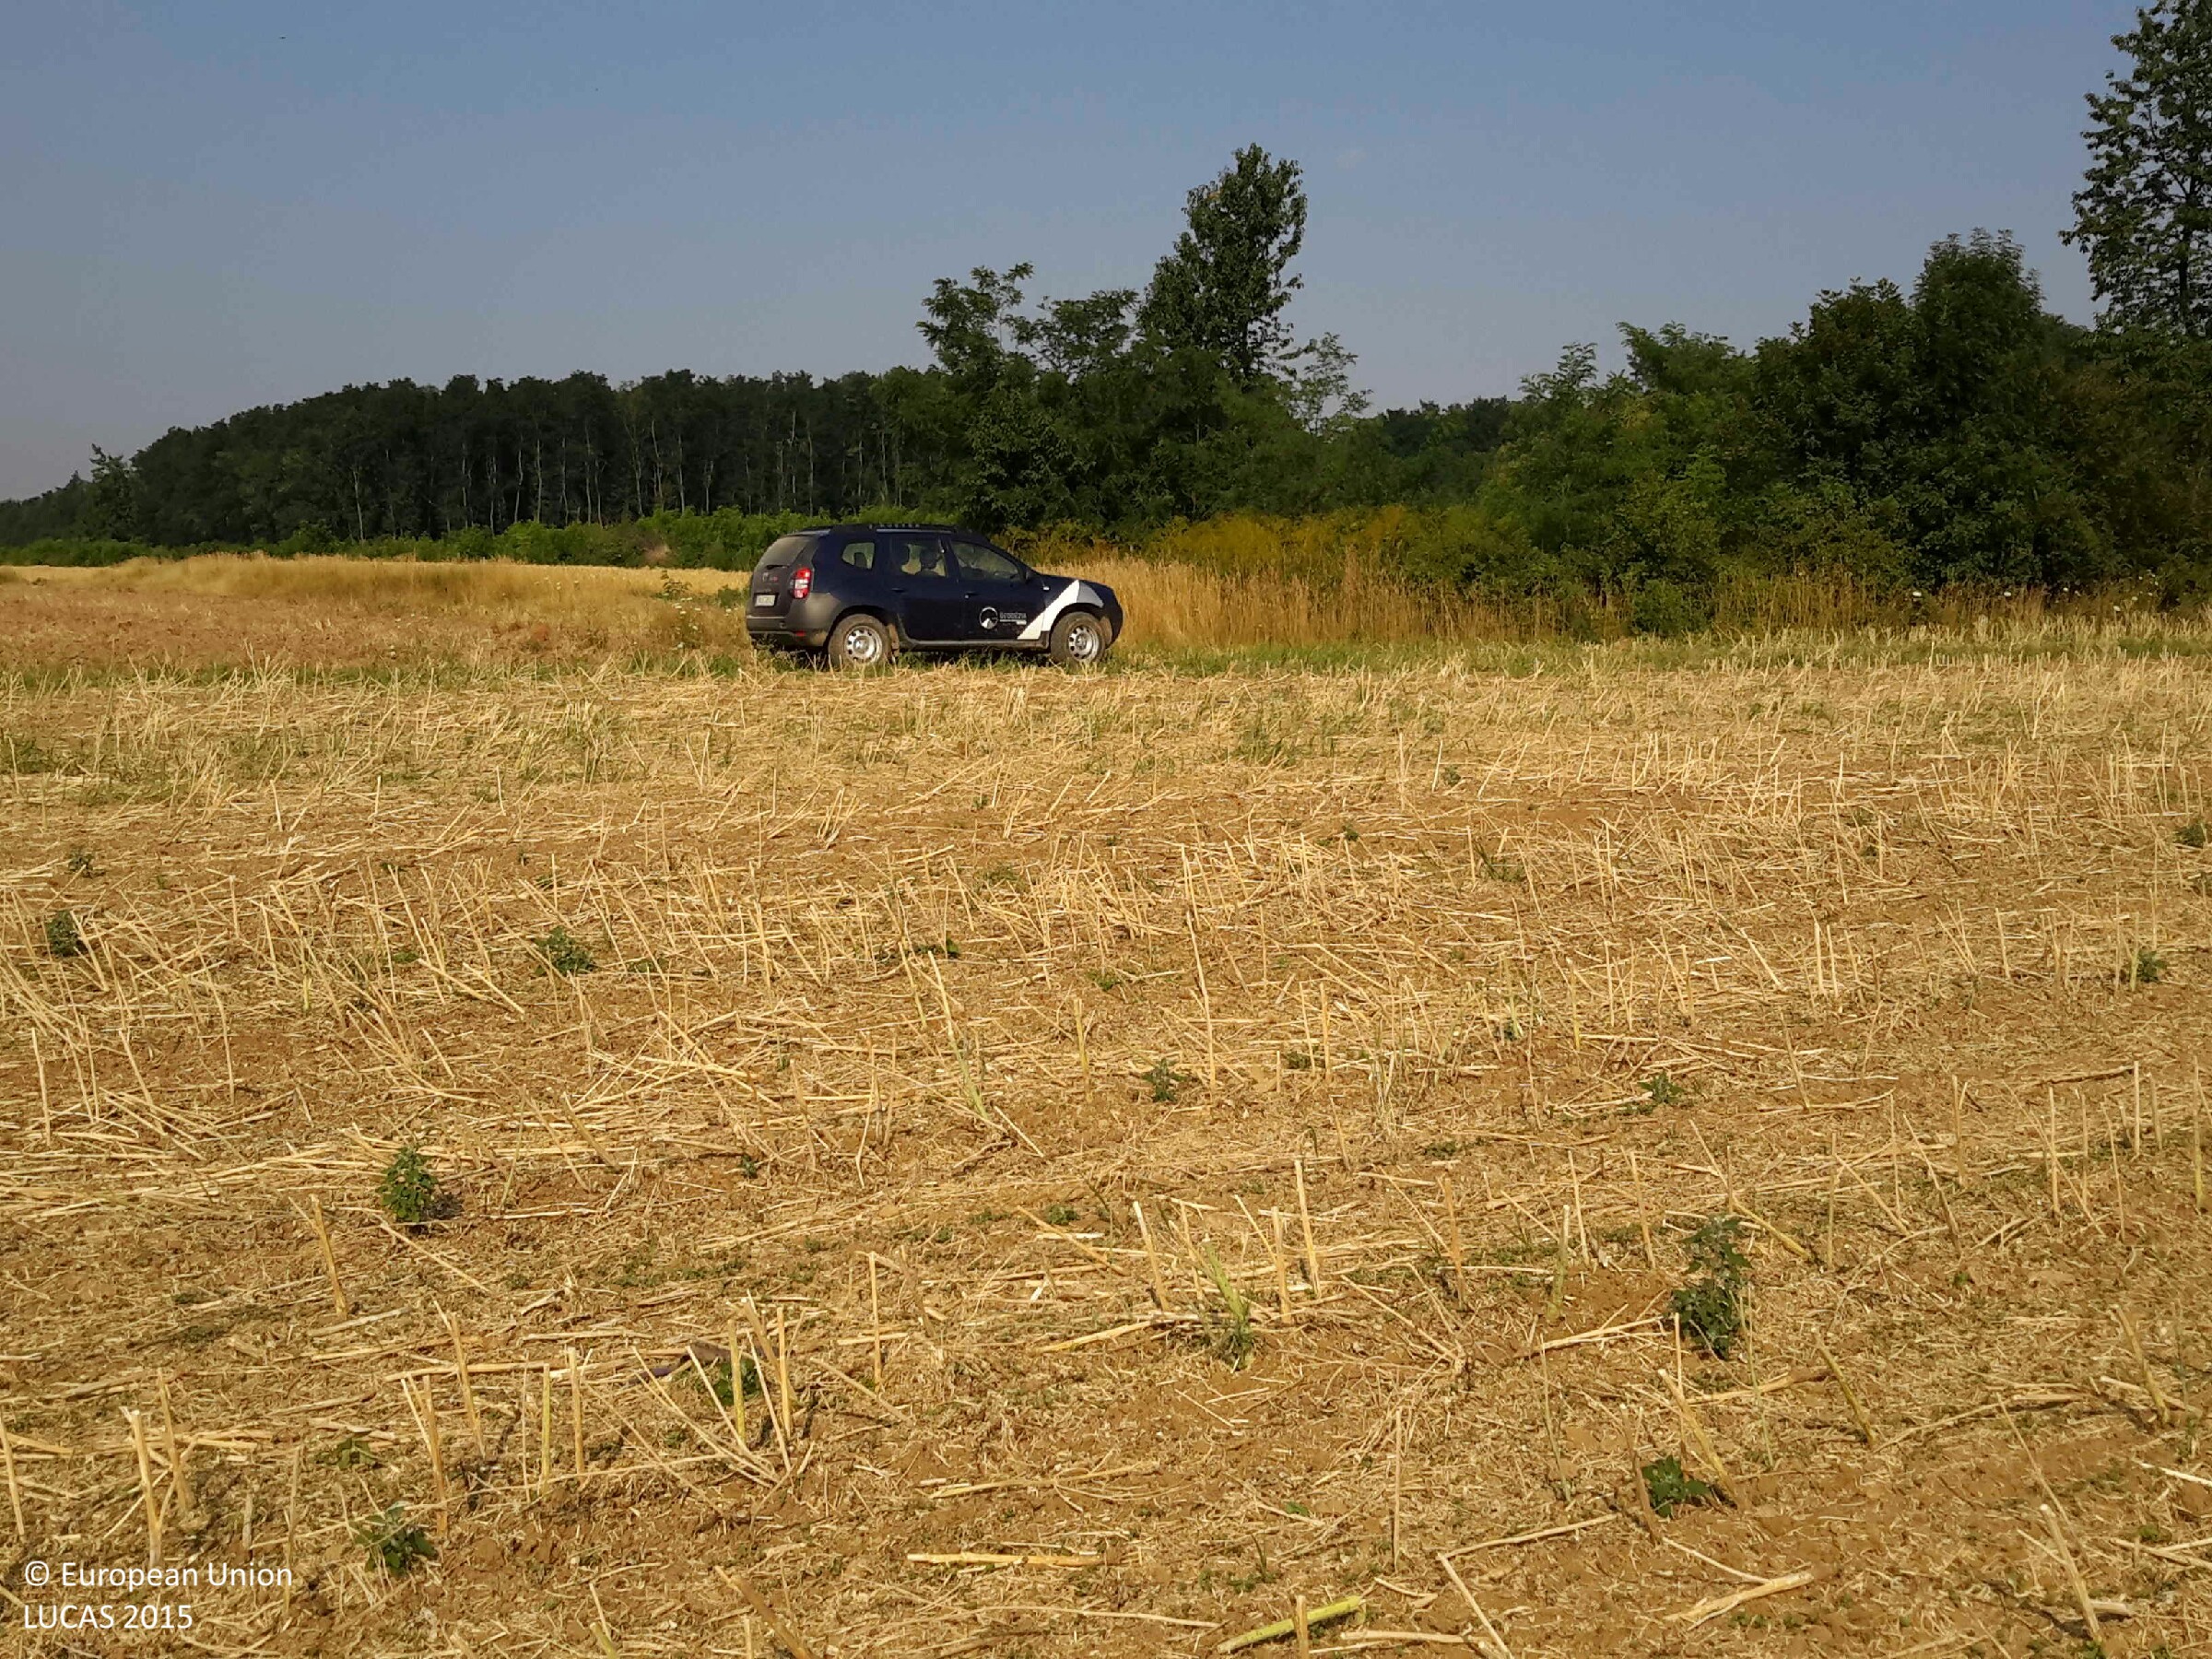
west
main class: Cropland
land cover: Rape and turnip rape
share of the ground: 10 - 25 %
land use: Agriculture (excluding fallow land and kitchen gardens)
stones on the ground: < 10 %
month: July
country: HU
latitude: 47.4450
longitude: 16.6482
